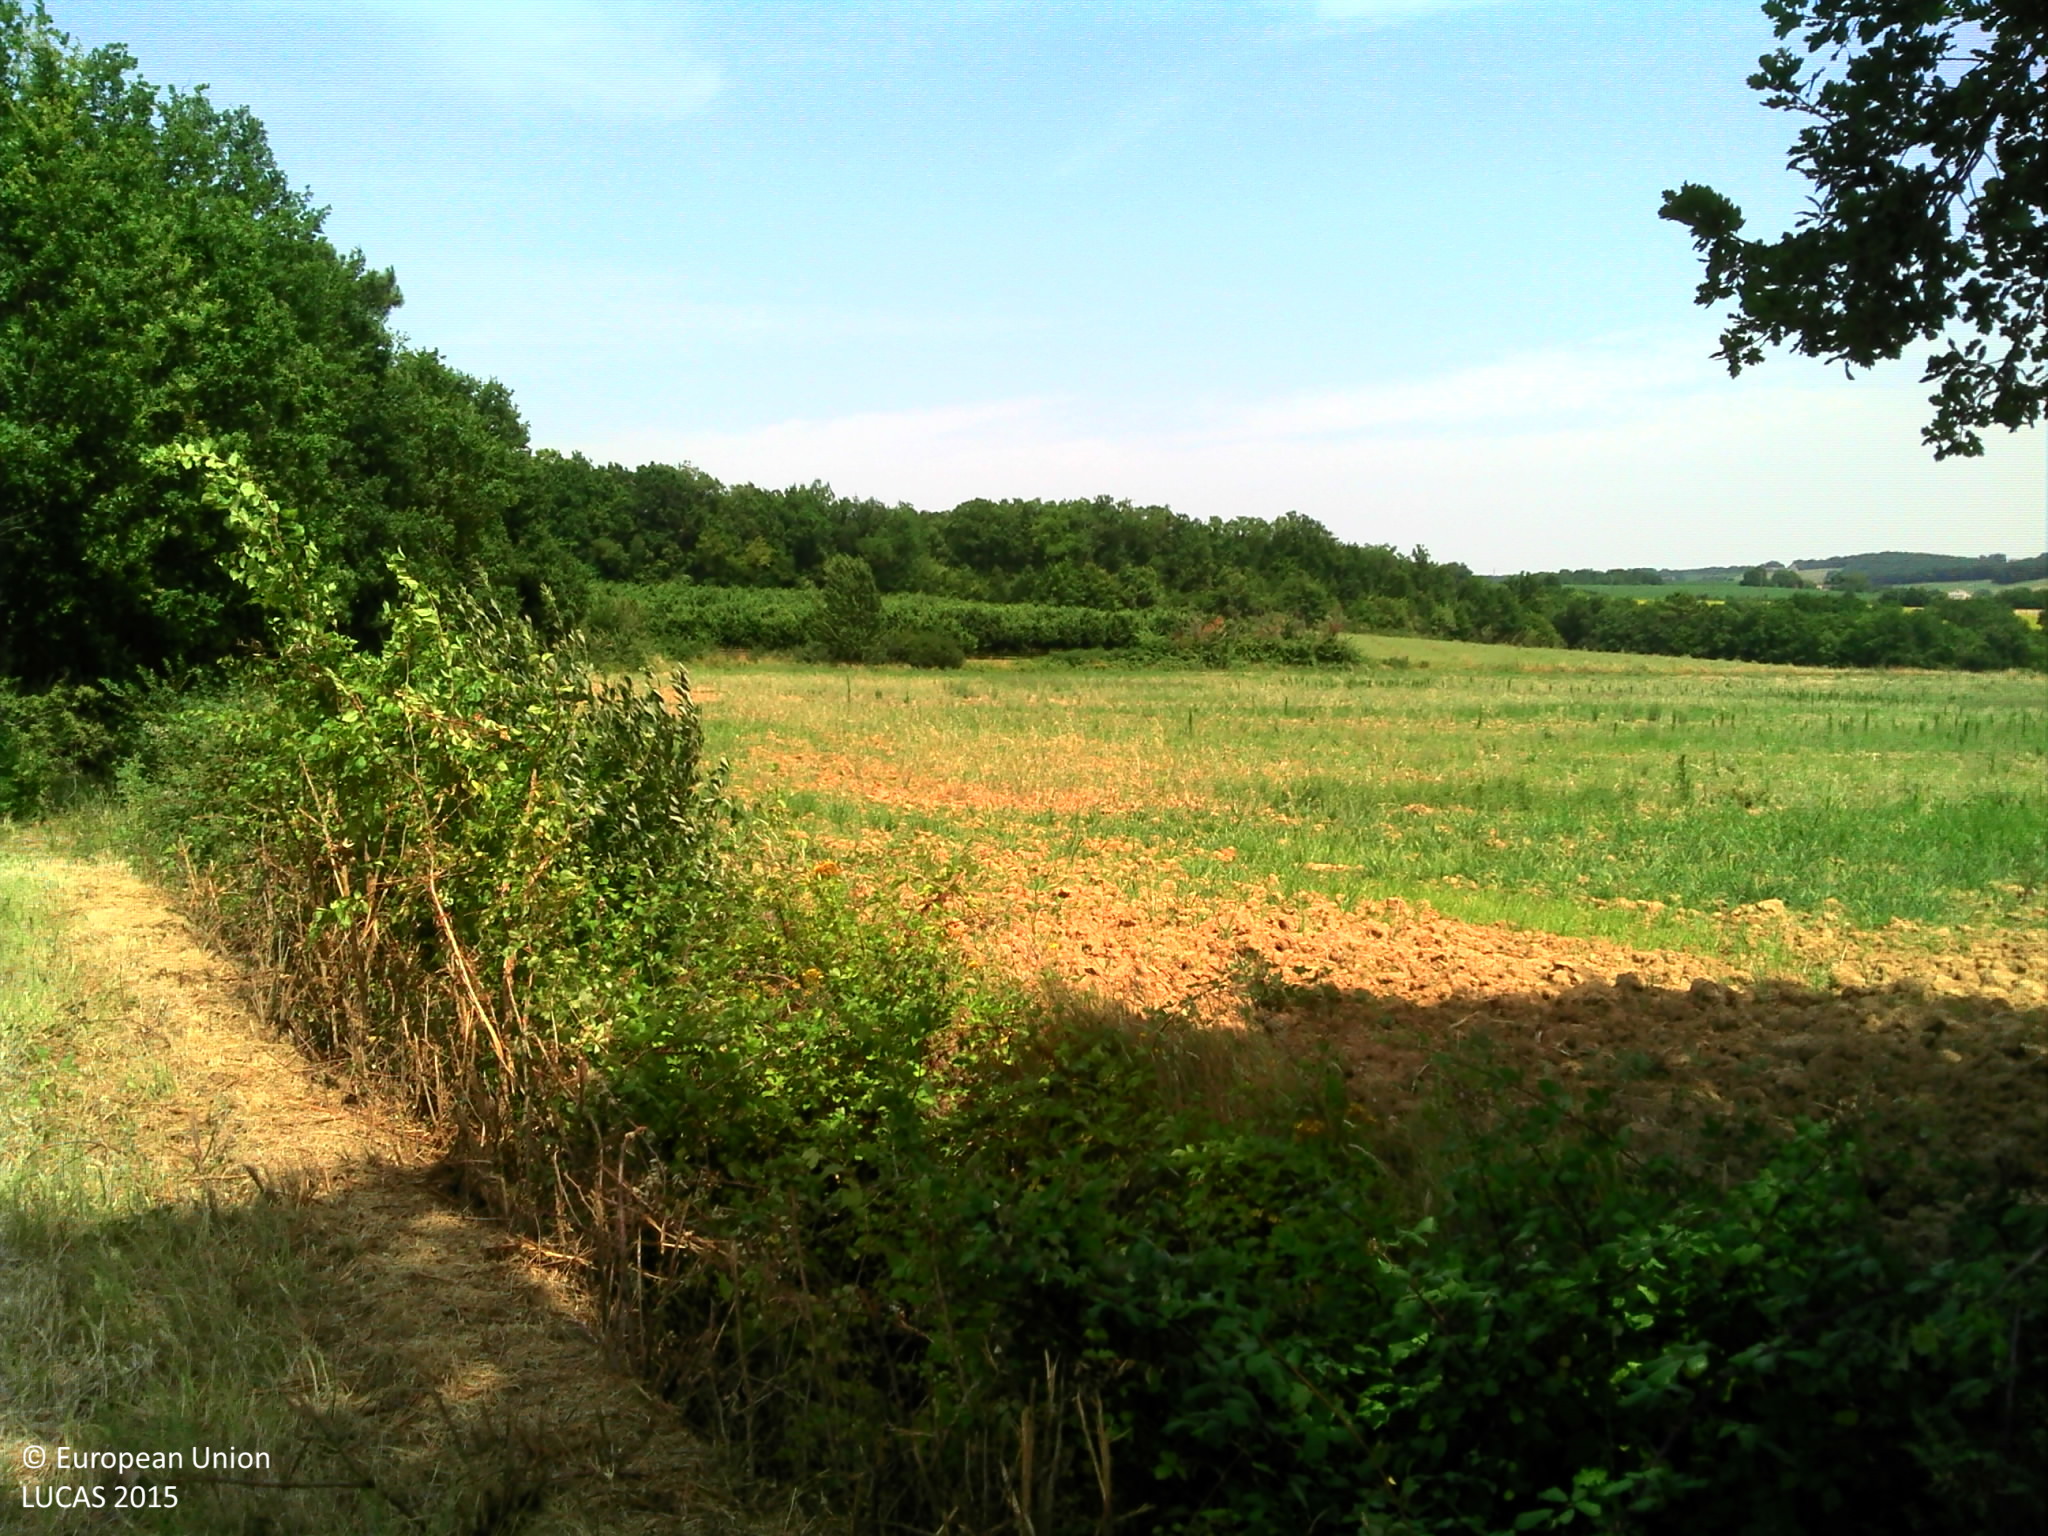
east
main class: Grassland
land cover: Grassland without tree/shrub cover
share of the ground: > 75 %
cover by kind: herbaceous plants 100 %
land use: Agriculture (excluding fallow land and kitchen gardens)
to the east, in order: Grassland without tree/shrub cover; Ditches and canals; Spontaneously vegetated surfaces; Ditches and canals; Grassland with sparse tree/shrub cover
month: July
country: FR
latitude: 44.5079
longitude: 0.8498
